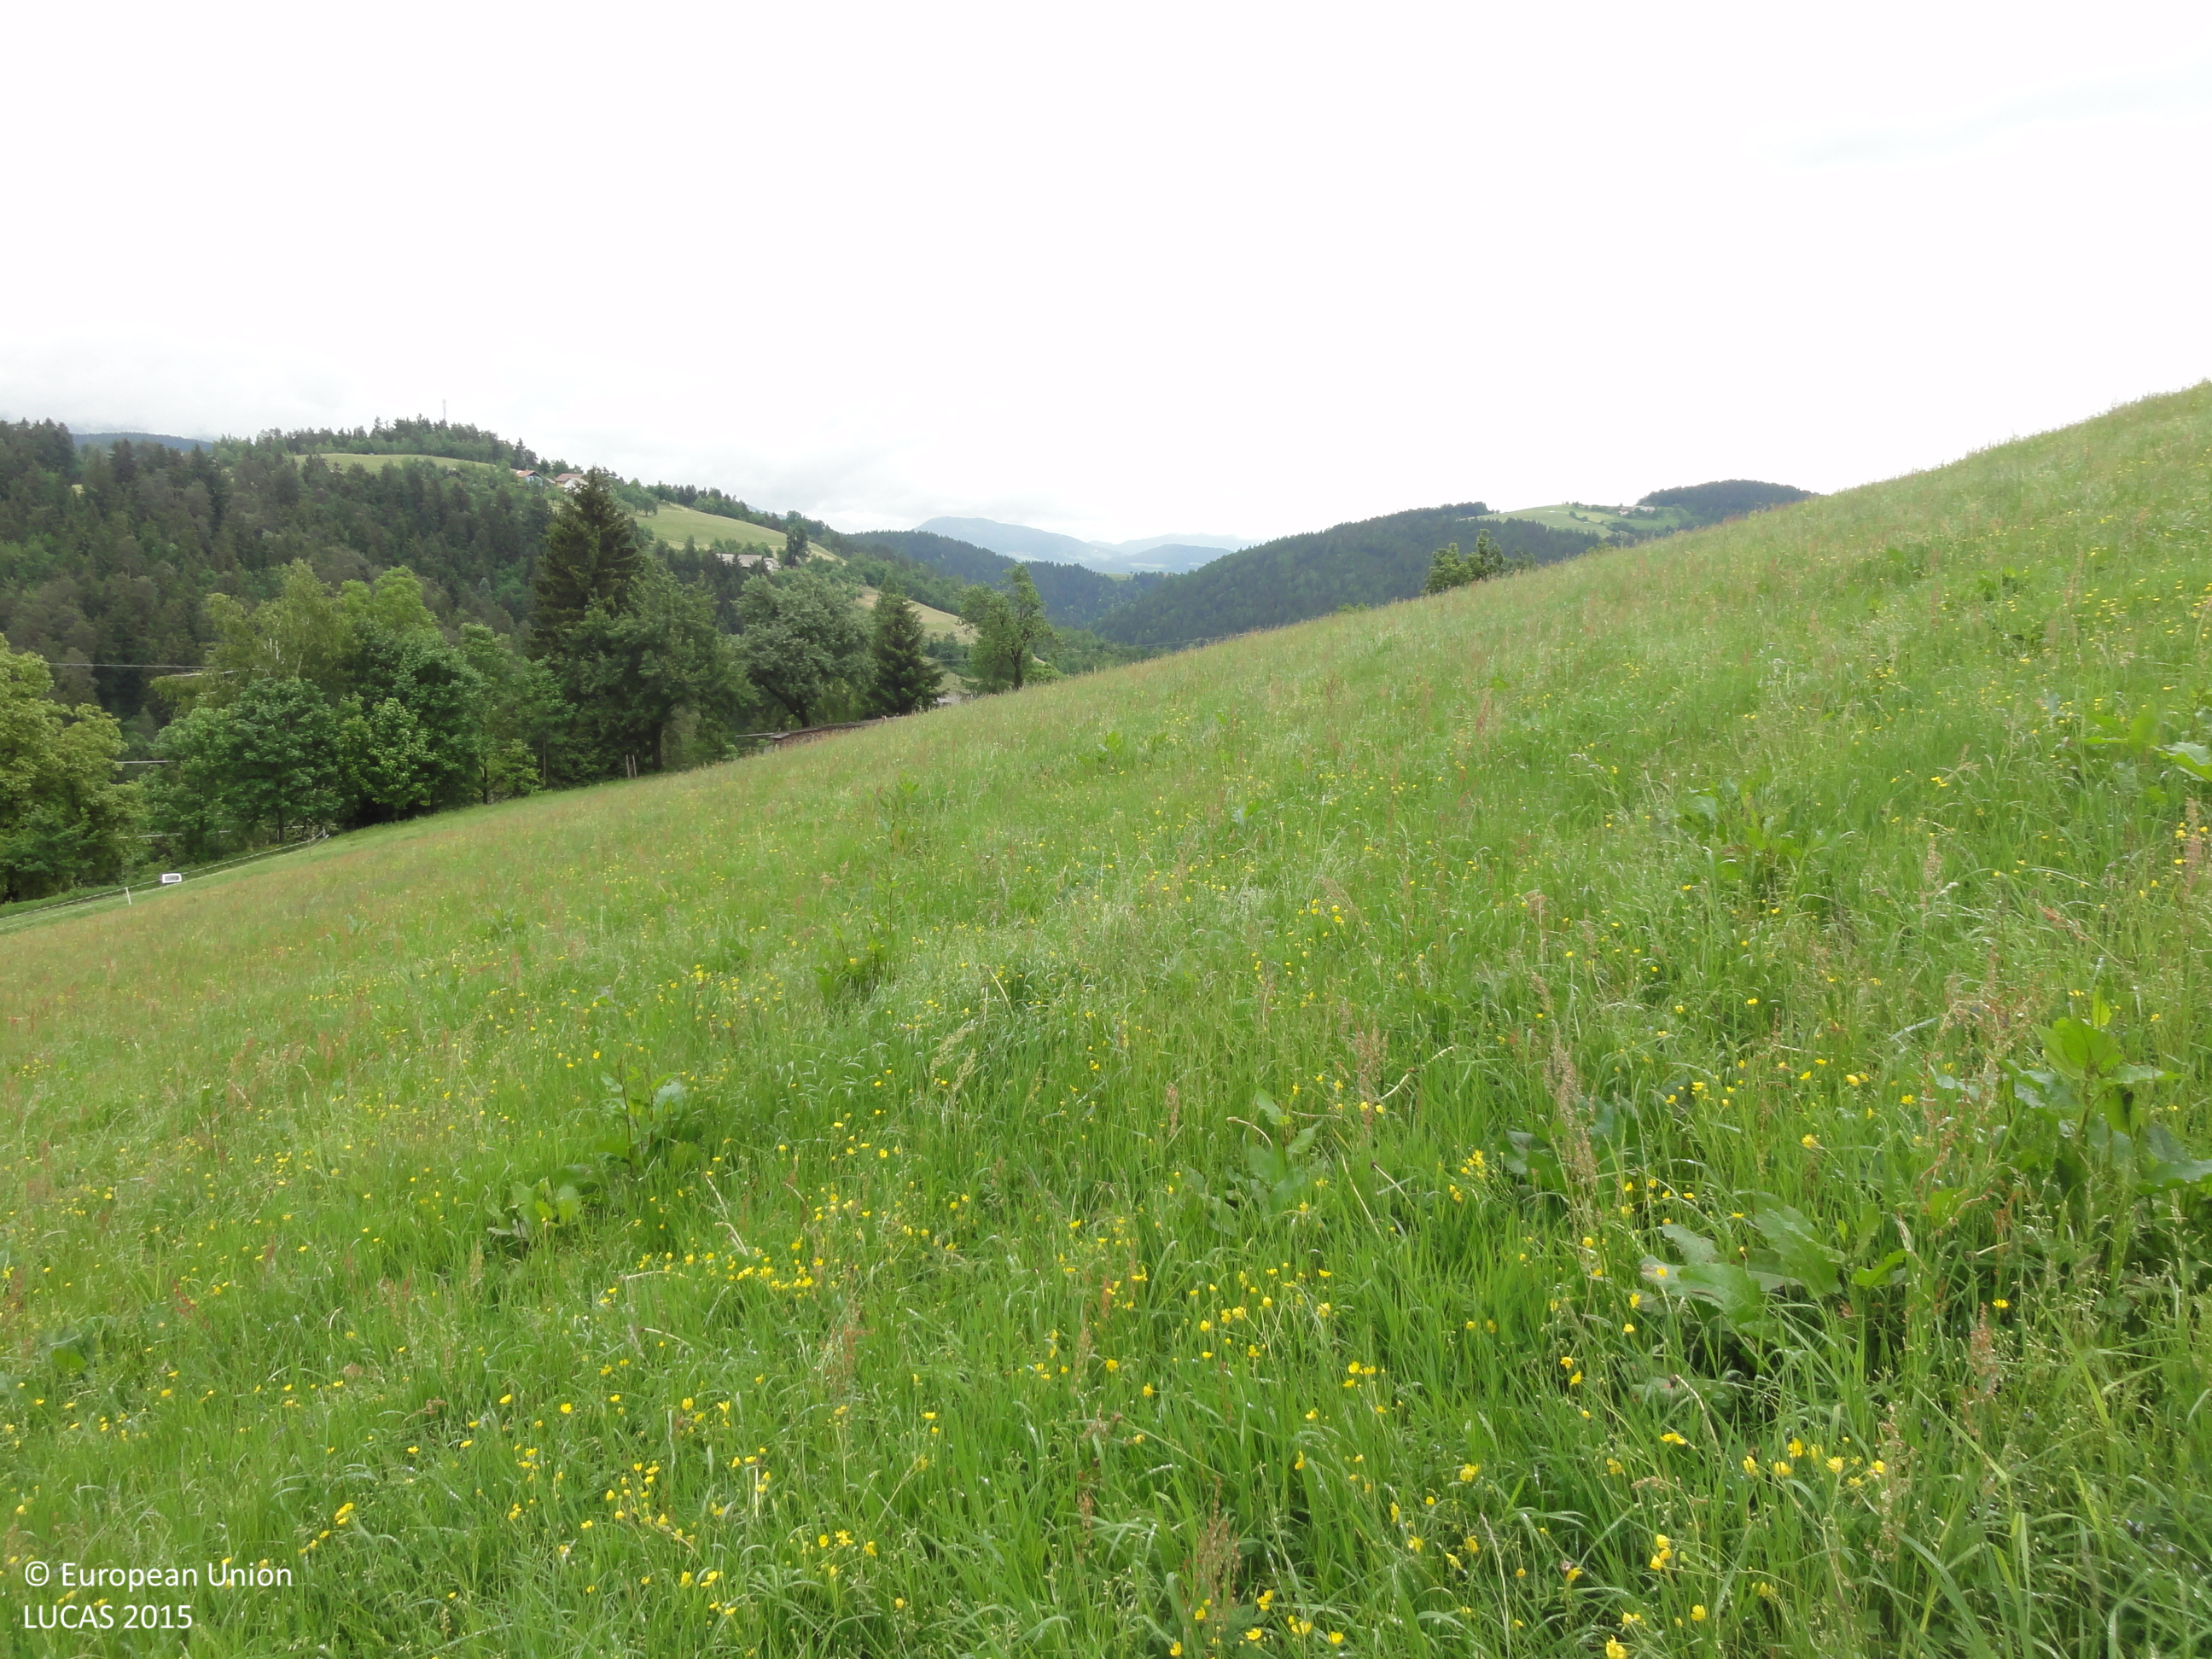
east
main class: Grassland
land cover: Grassland without tree/shrub cover
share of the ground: > 75 %
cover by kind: herbaceous plants 100 %
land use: Agriculture (excluding fallow land and kitchen gardens)
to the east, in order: Grassland without tree/shrub cover; Fences; Apple fruit; Fences; Grassland with sparse tree/shrub cover; Artificial constructions in urban areas; Apple fruit; Pear fruit; Fences; Tracks; Grassland with sparse tree/shrub cover; Fences; Grassland without tree/shrub cover; Electric lines; Grassland without tree/shrub cover
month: May
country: SI
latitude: 46.5474
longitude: 14.8623
